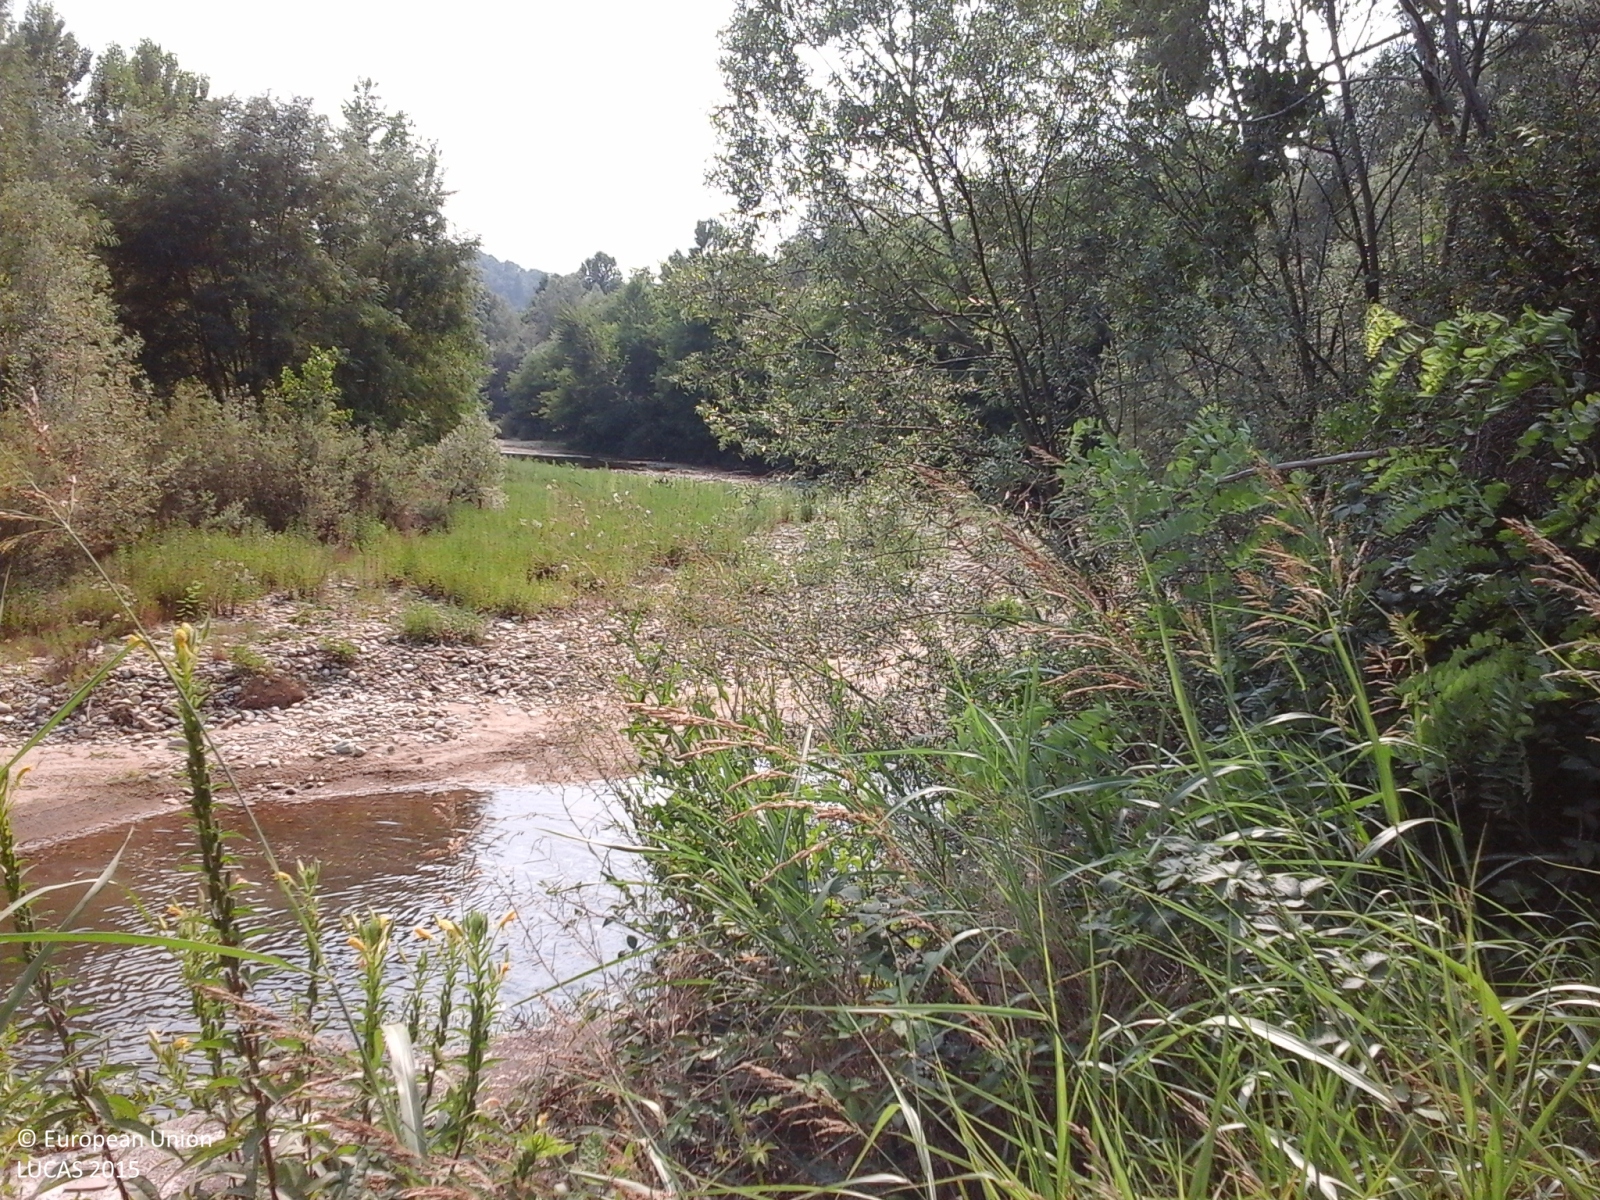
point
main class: Woodland
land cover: Broadleaved woodland
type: floodplain forest
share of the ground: > 75 %
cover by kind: broadleaved forest trees 100 %
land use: Semi-natural and natural areas not in use
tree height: > 5 m
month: July
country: IT
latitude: 45.2804
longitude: 7.6709
